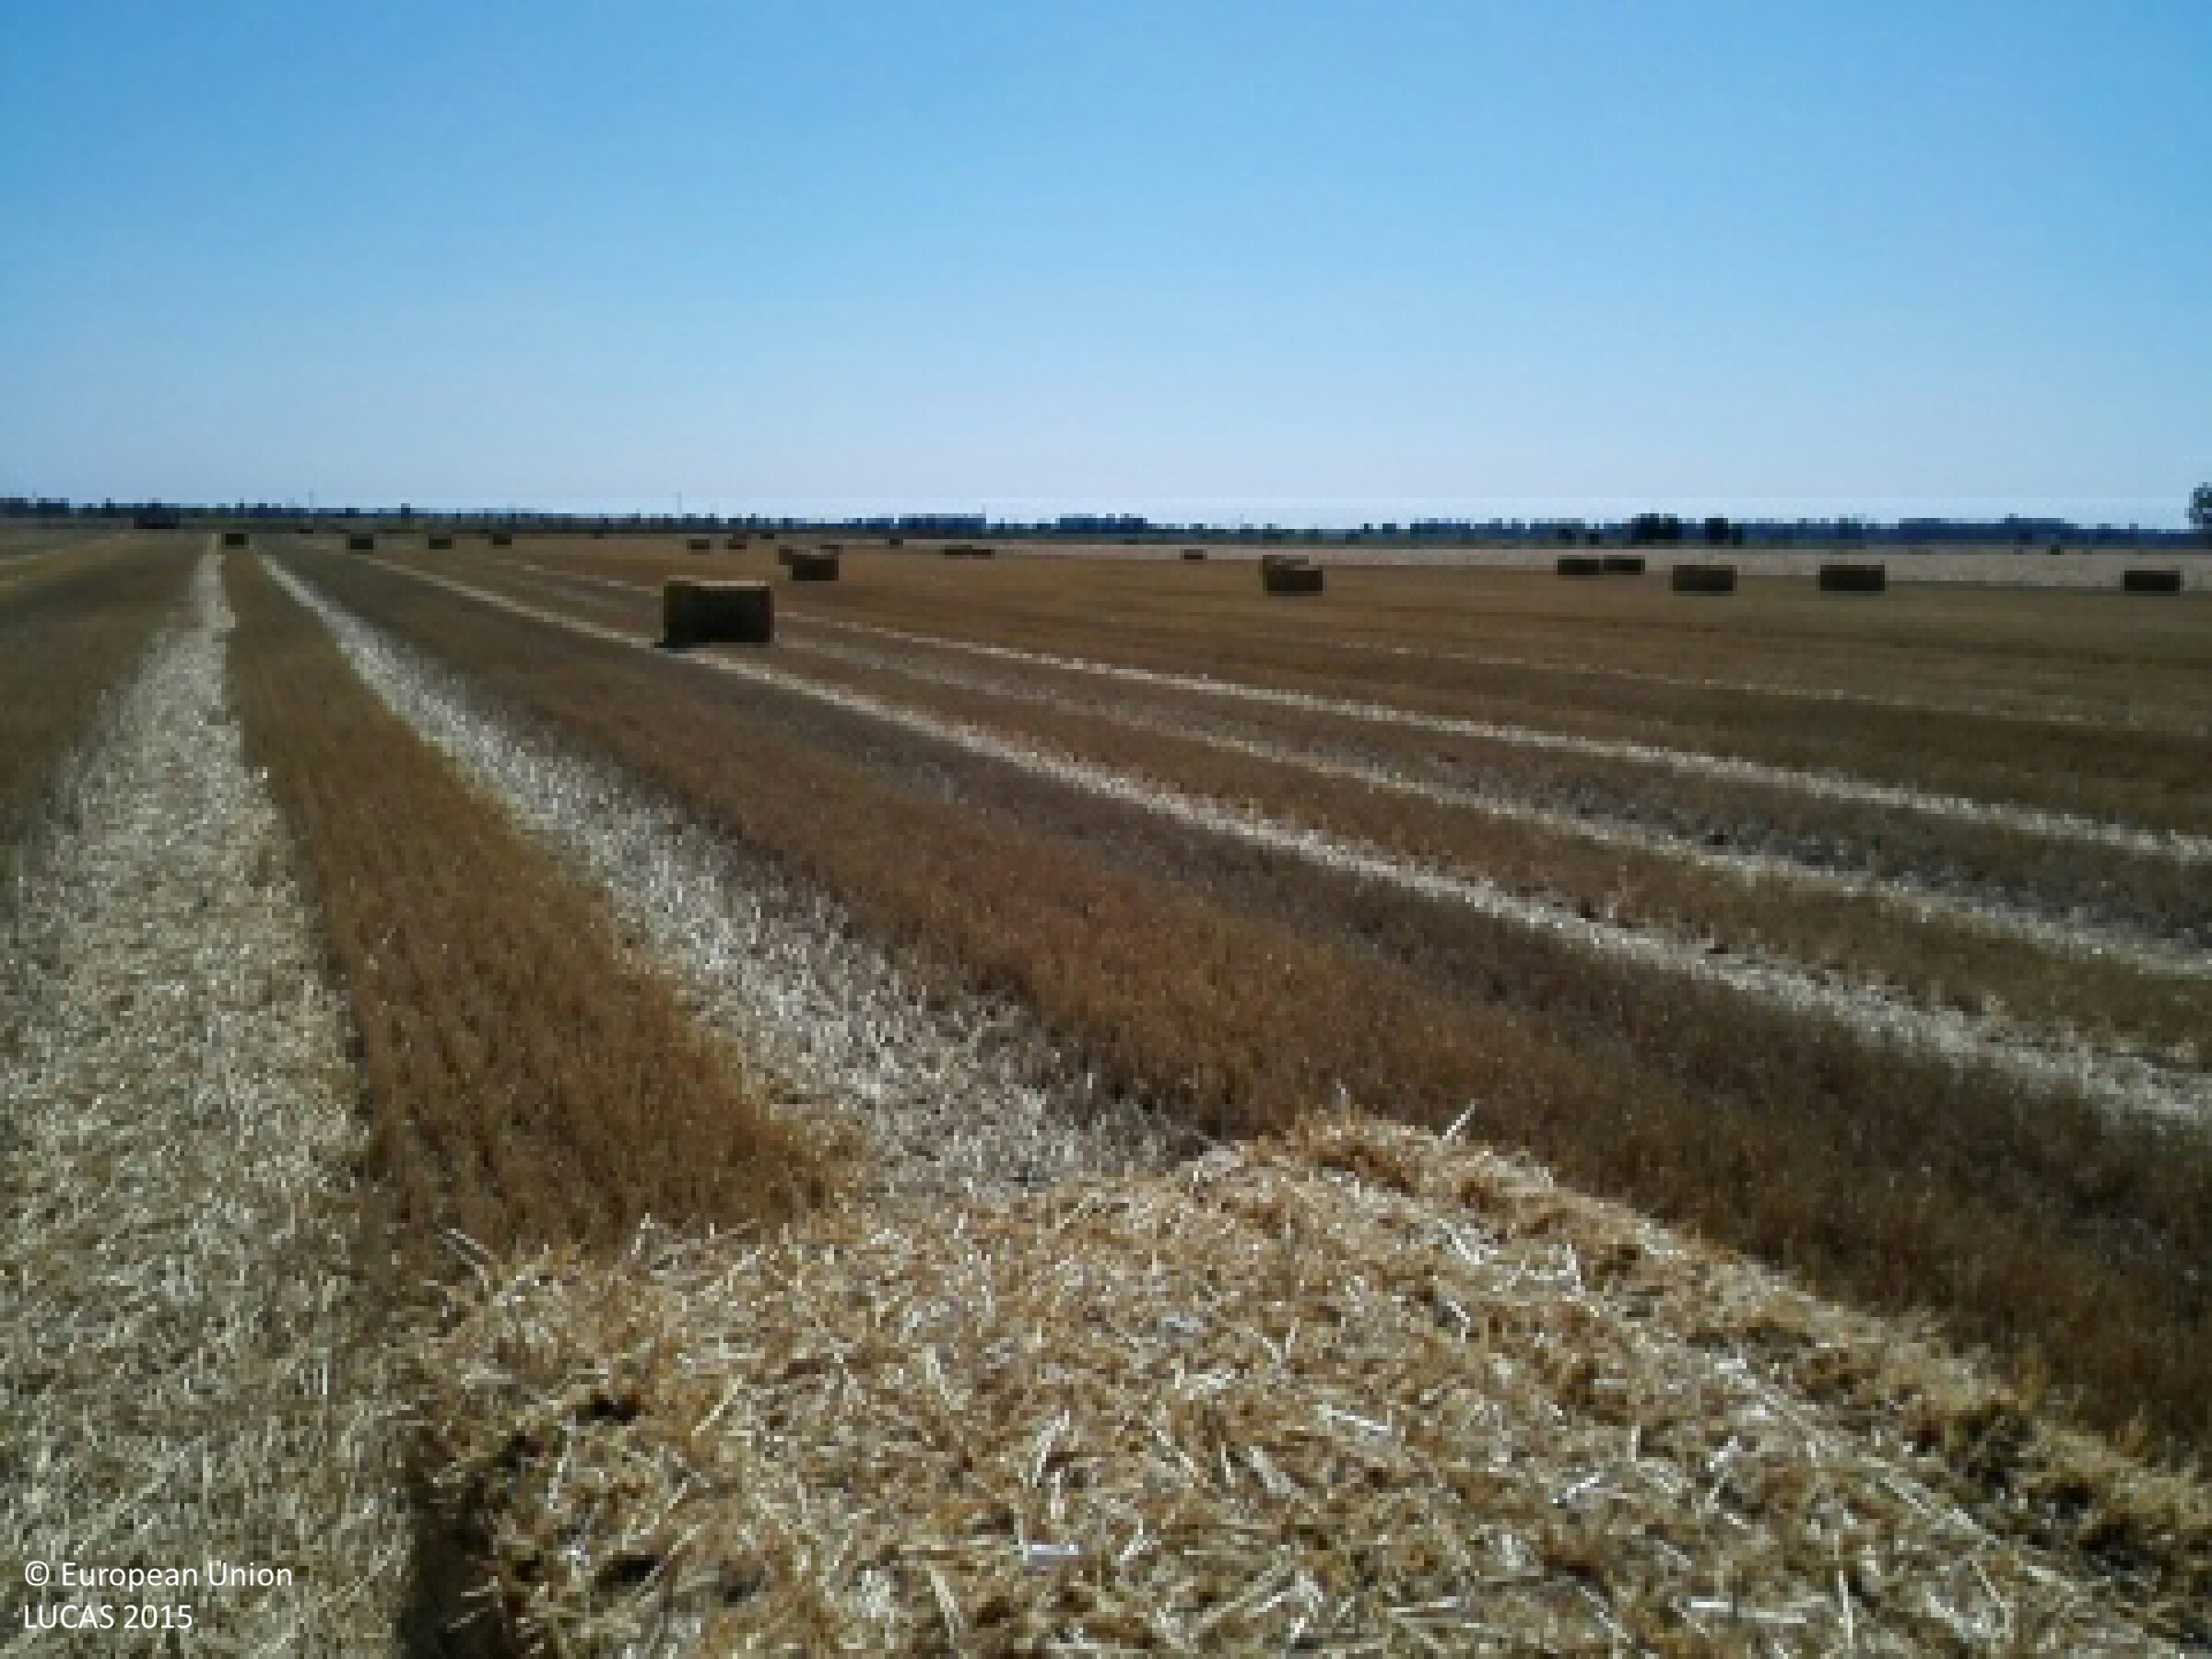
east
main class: Cropland
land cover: Common wheat
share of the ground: 50 - 75 %
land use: Agriculture (excluding fallow land and kitchen gardens)
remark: Harvested field
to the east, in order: Common wheat
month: July
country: HU
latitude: 47.7139
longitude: 21.4666
